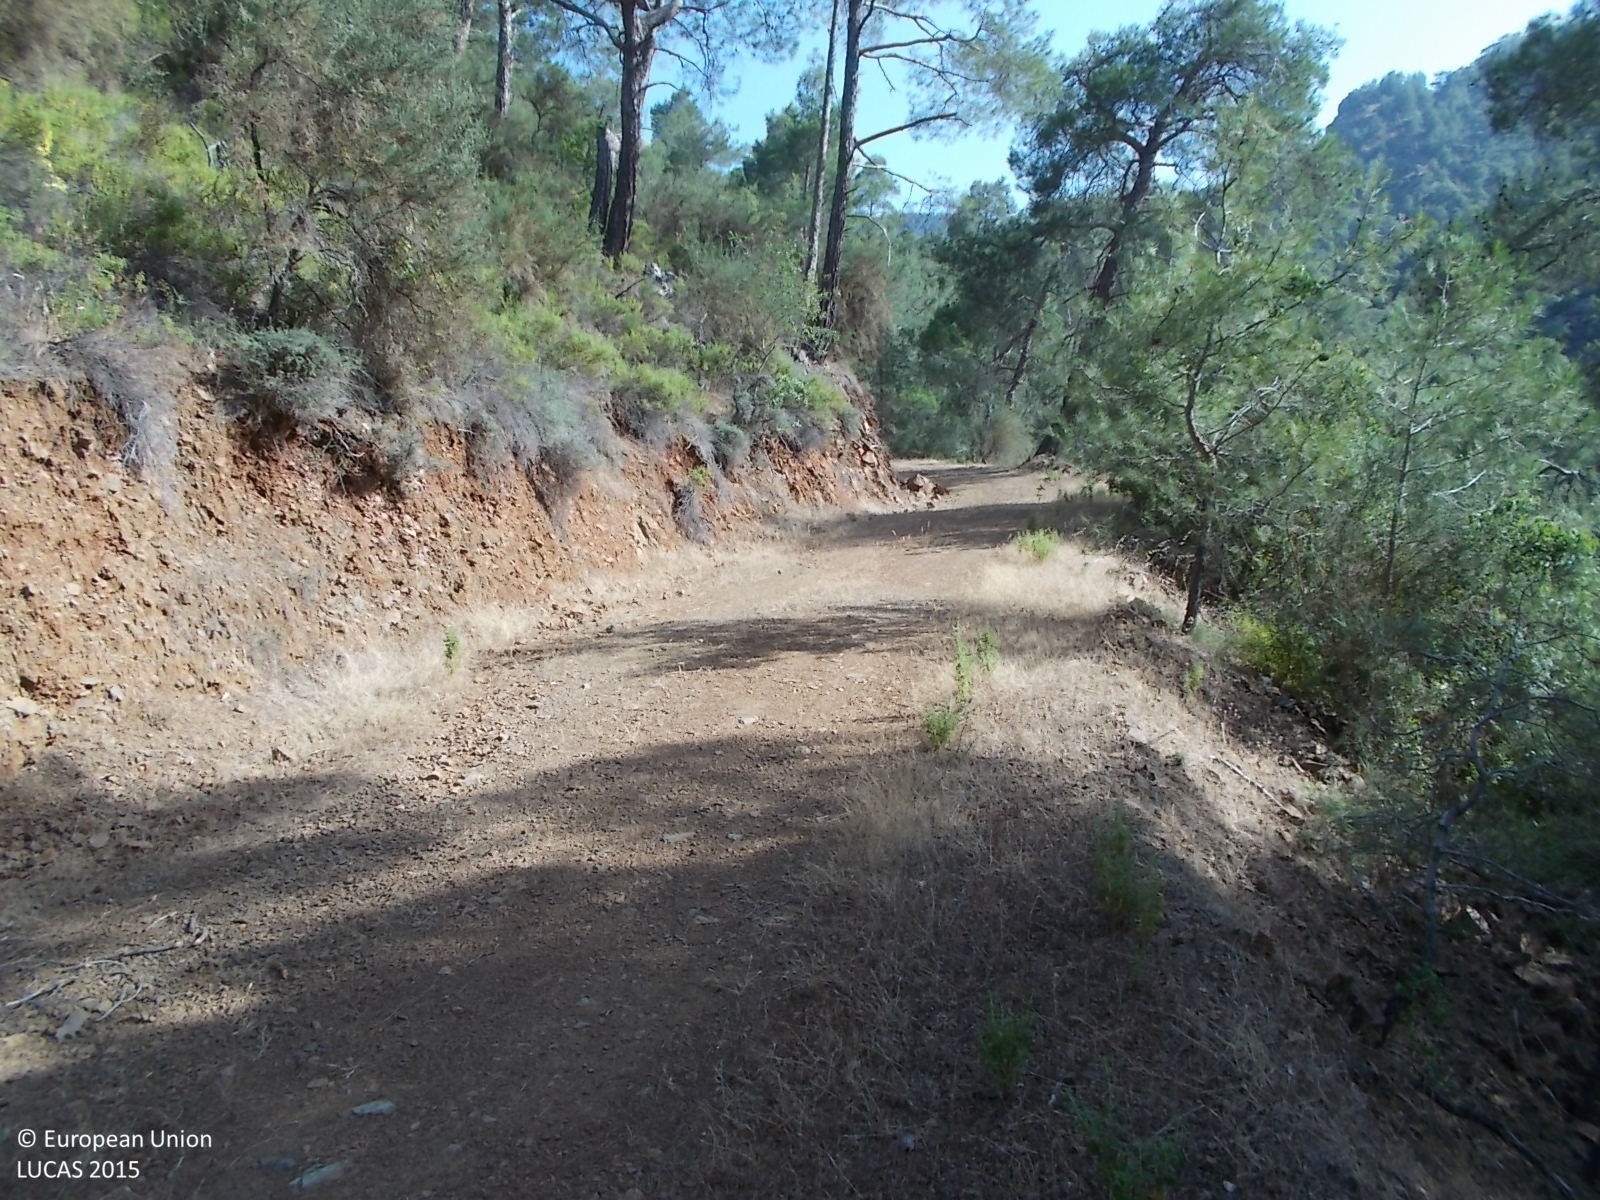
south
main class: Woodland
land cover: Pine dominated mixed woodland
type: coniferous forest of the mediterranean region
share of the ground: > 75 %
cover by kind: coniferous forest trees 50 %, broadleaved forest trees 25 %, unconsolidated bare surface 15 %, shrubs 10 %
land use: Forestry
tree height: > 5 m
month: June
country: CY
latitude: 35.1437
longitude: 32.6552
